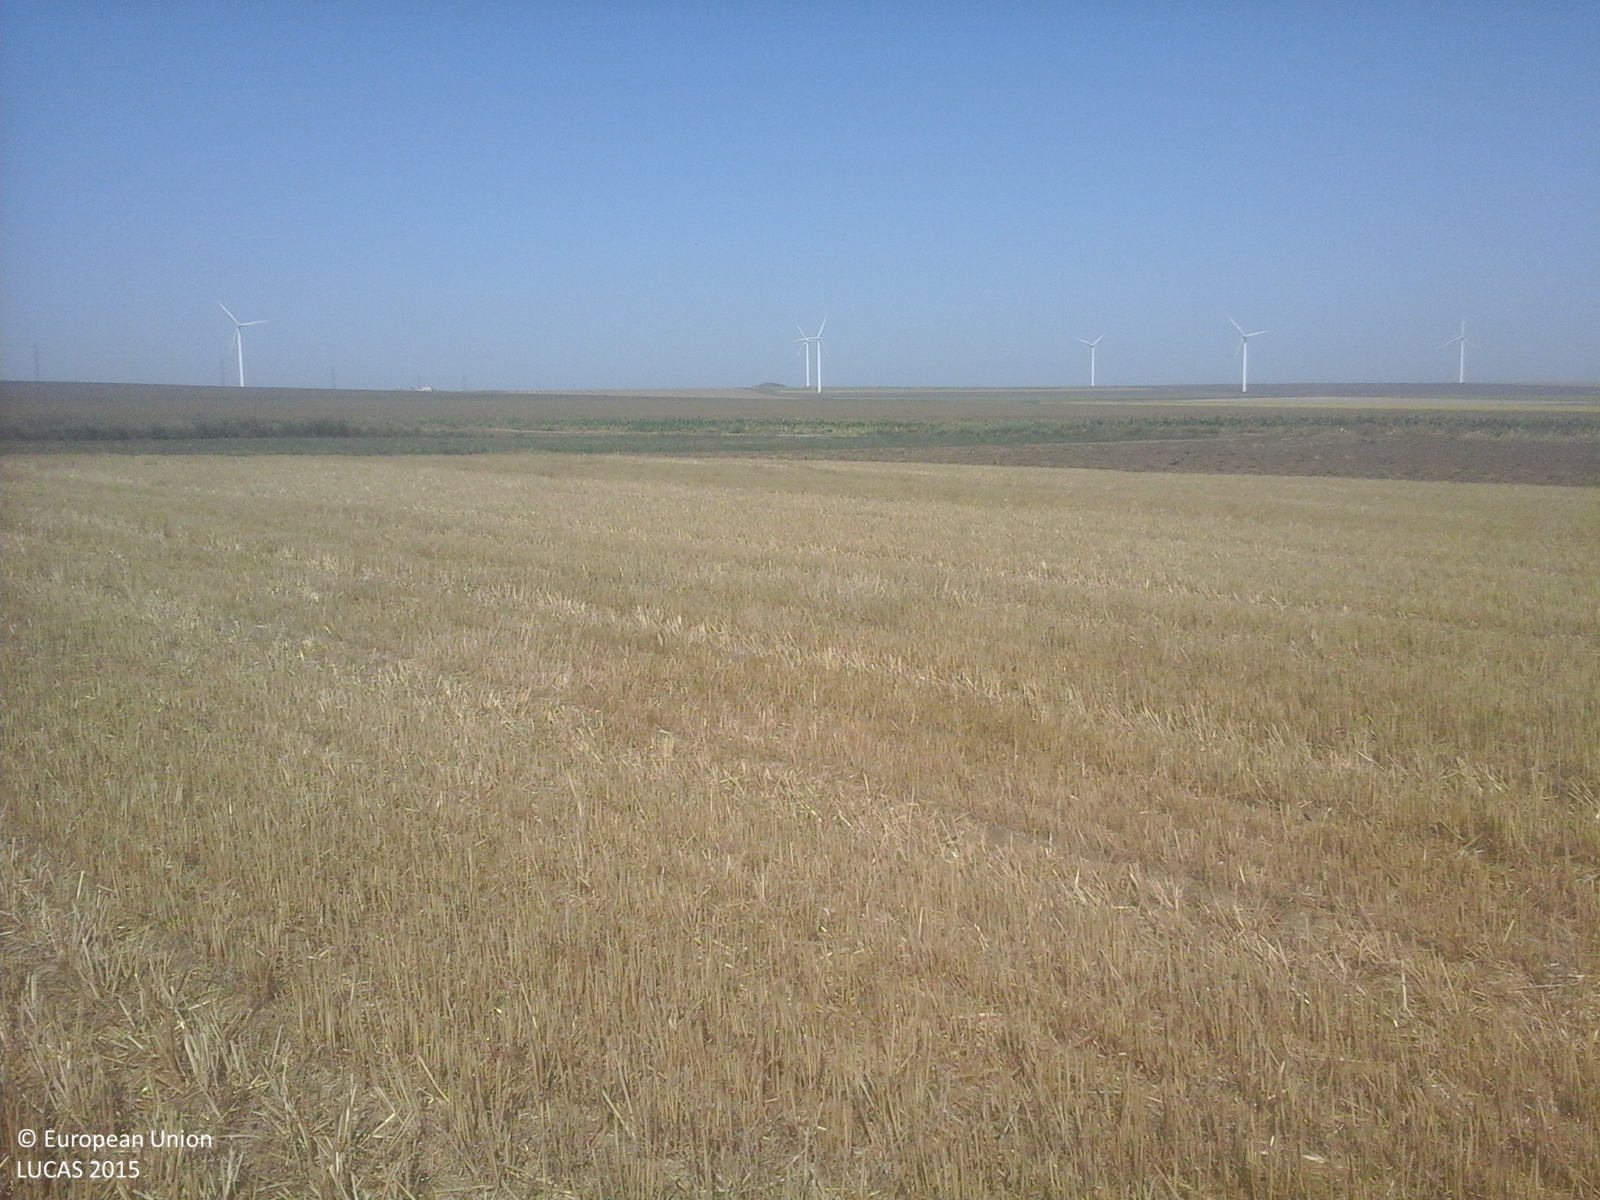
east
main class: Cropland
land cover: Common wheat
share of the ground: > 75 %
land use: Agriculture (excluding fallow land and kitchen gardens)
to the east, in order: Common wheat; Grass margins; Tracks; Shruby margins; Maize
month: August
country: RO
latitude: 44.4240
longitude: 28.3950
